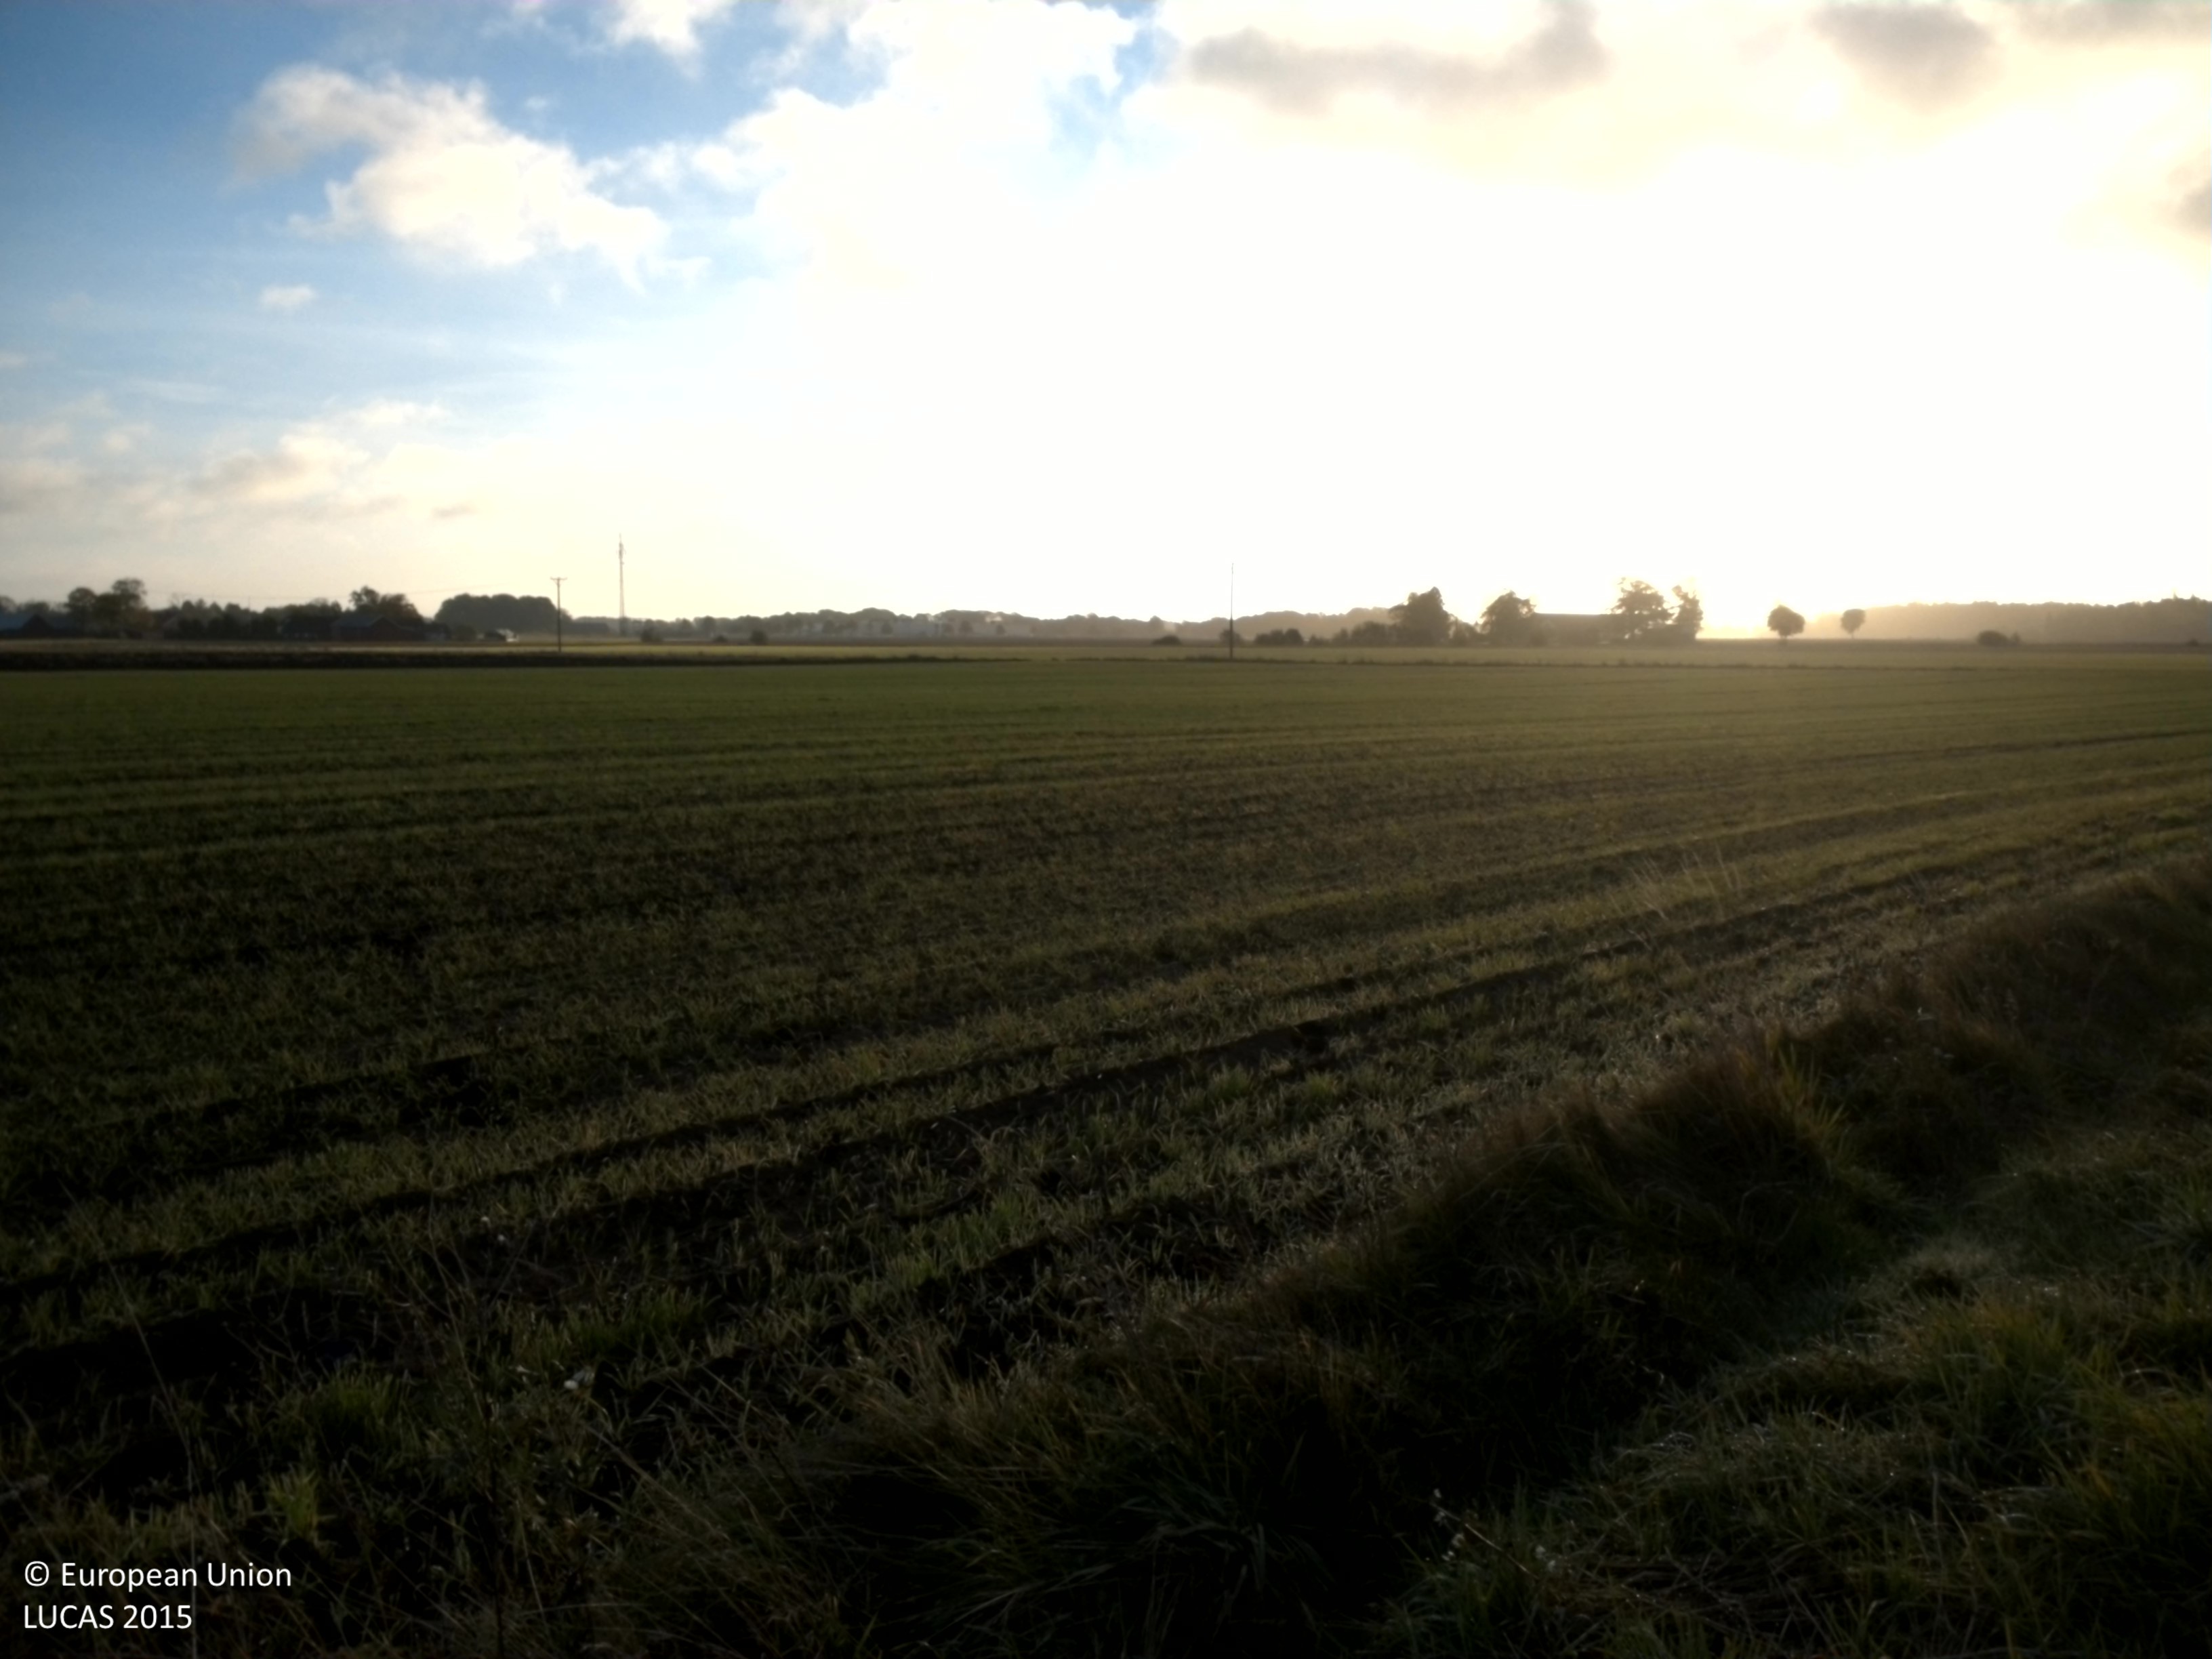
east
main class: Grassland
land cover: Grassland without tree/shrub cover
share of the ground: > 75 %
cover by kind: herbaceous plants 100 %
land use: Agriculture (excluding fallow land and kitchen gardens)
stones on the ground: < 10 %
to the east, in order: Grassland without tree/shrub cover; Common wheat; Electric lines; Grass margins; Common wheat
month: October
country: SE
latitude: 58.2406
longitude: 12.9757
